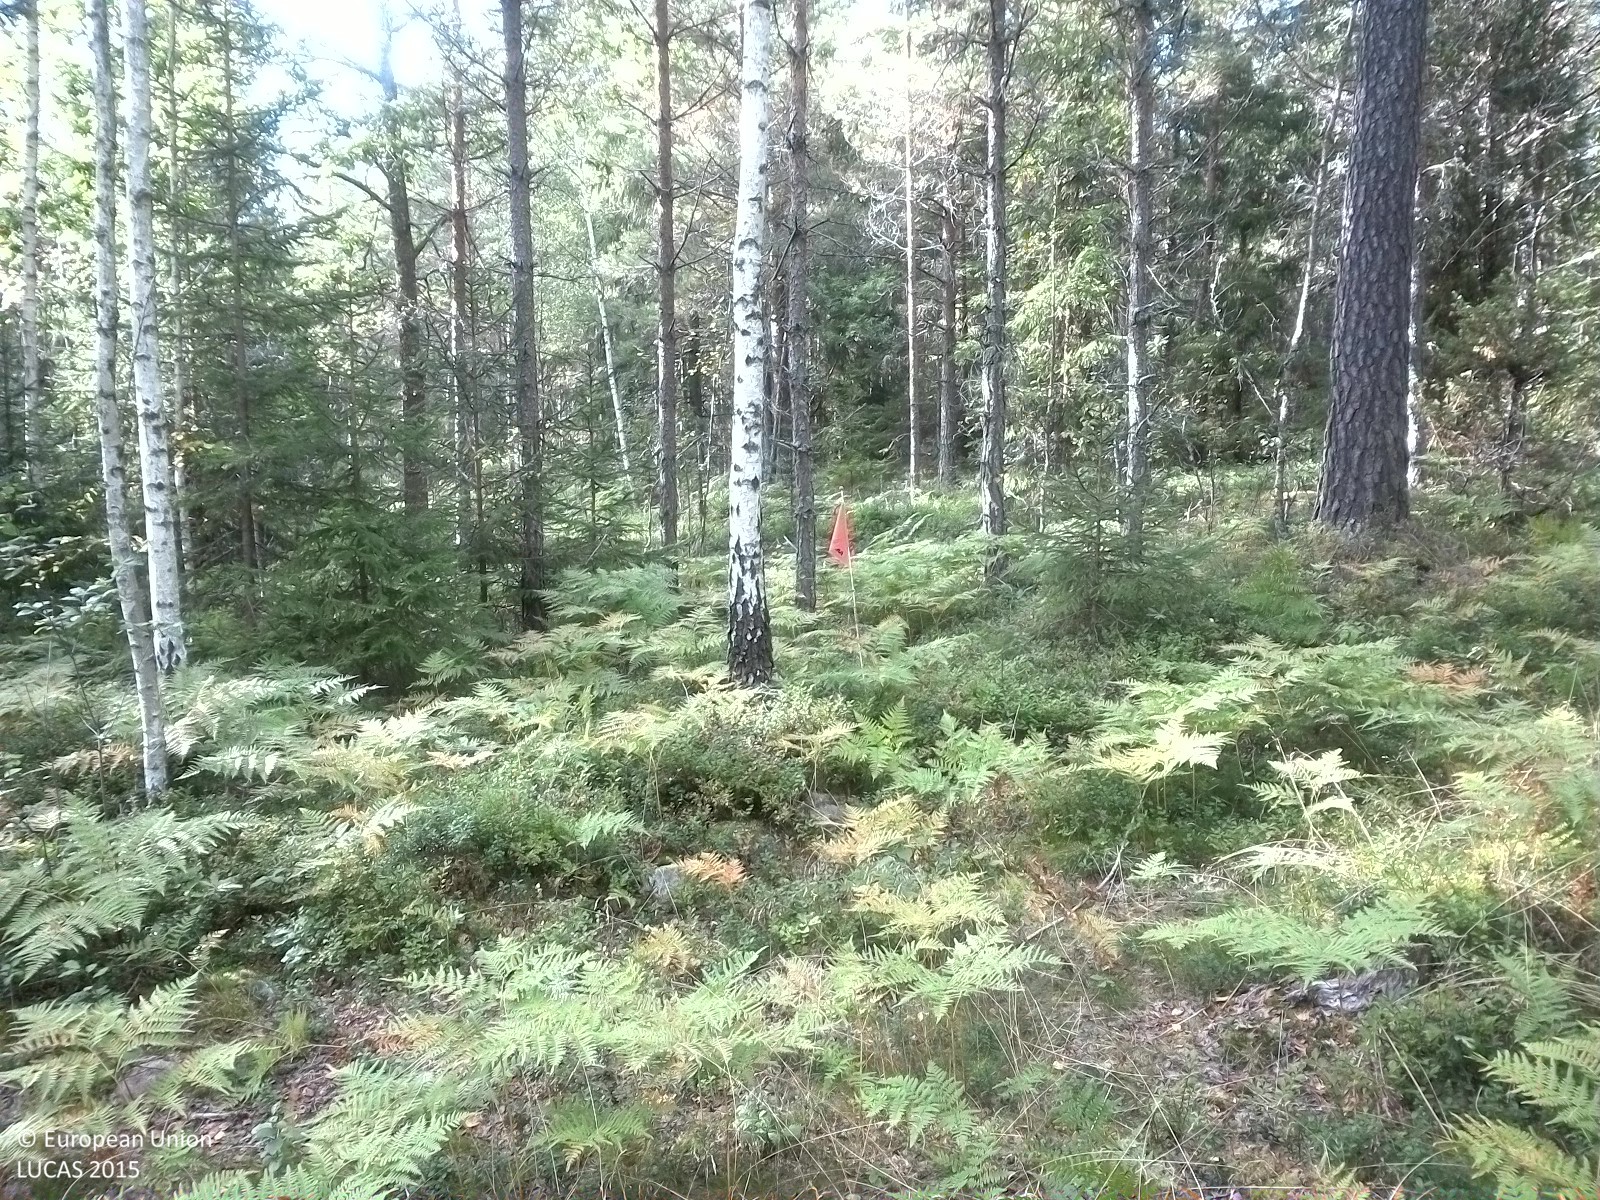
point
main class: Woodland
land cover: Pine dominated mixed woodland
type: boreal forest
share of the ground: 25 - 50 %
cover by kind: herbaceous plants 45 %, coniferous forest trees 25 %, broadleaved forest trees 20 %, lichens and mosses 10 %
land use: Forestry
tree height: > 5 m
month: September
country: SE
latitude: 58.9940
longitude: 15.8584
